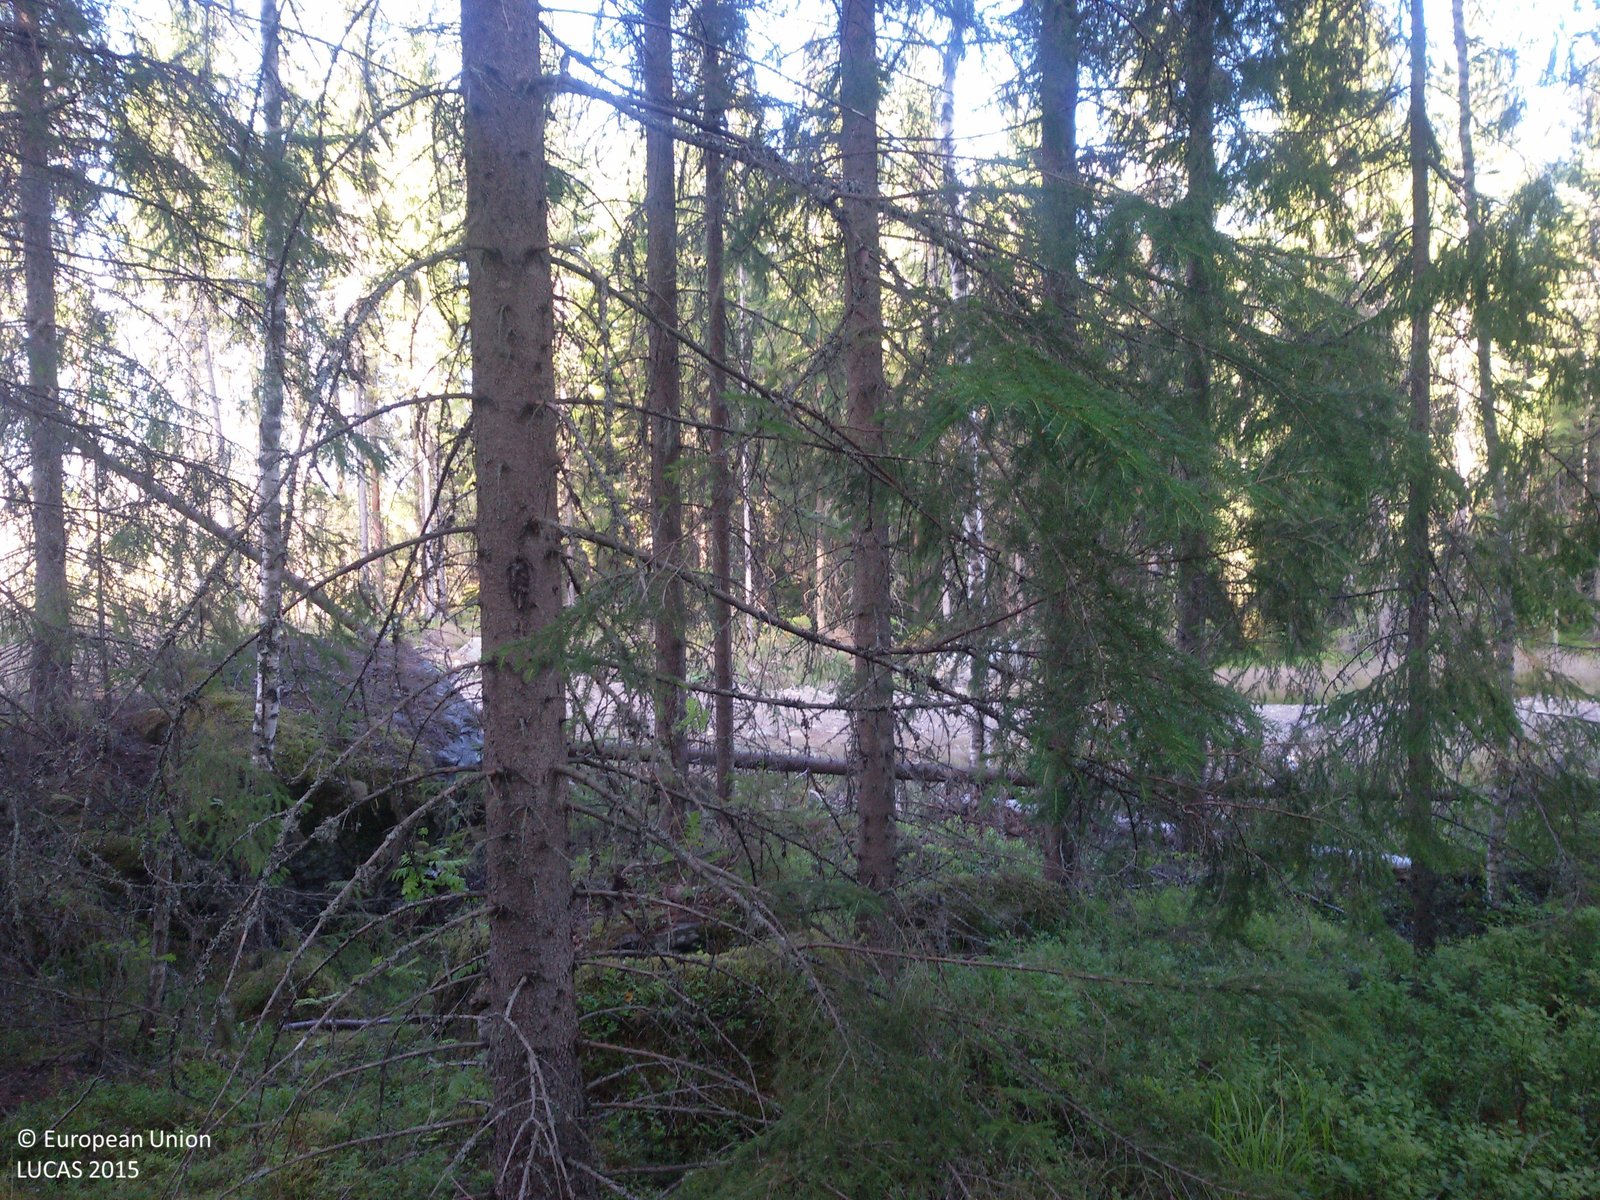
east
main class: Woodland
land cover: Spruce dominated mixed woodland
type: boreal forest
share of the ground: > 75 %
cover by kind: coniferous forest trees 40 %, broadleaved forest trees 40 %, herbaceous plants 10 %, lichens and mosses 10 %
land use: Forestry
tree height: > 5 m
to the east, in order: Spruce dominated mixed woodland; Tracks; Spruce dominated coniferous woodland
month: July
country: SE
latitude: 60.6735
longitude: 15.3866
